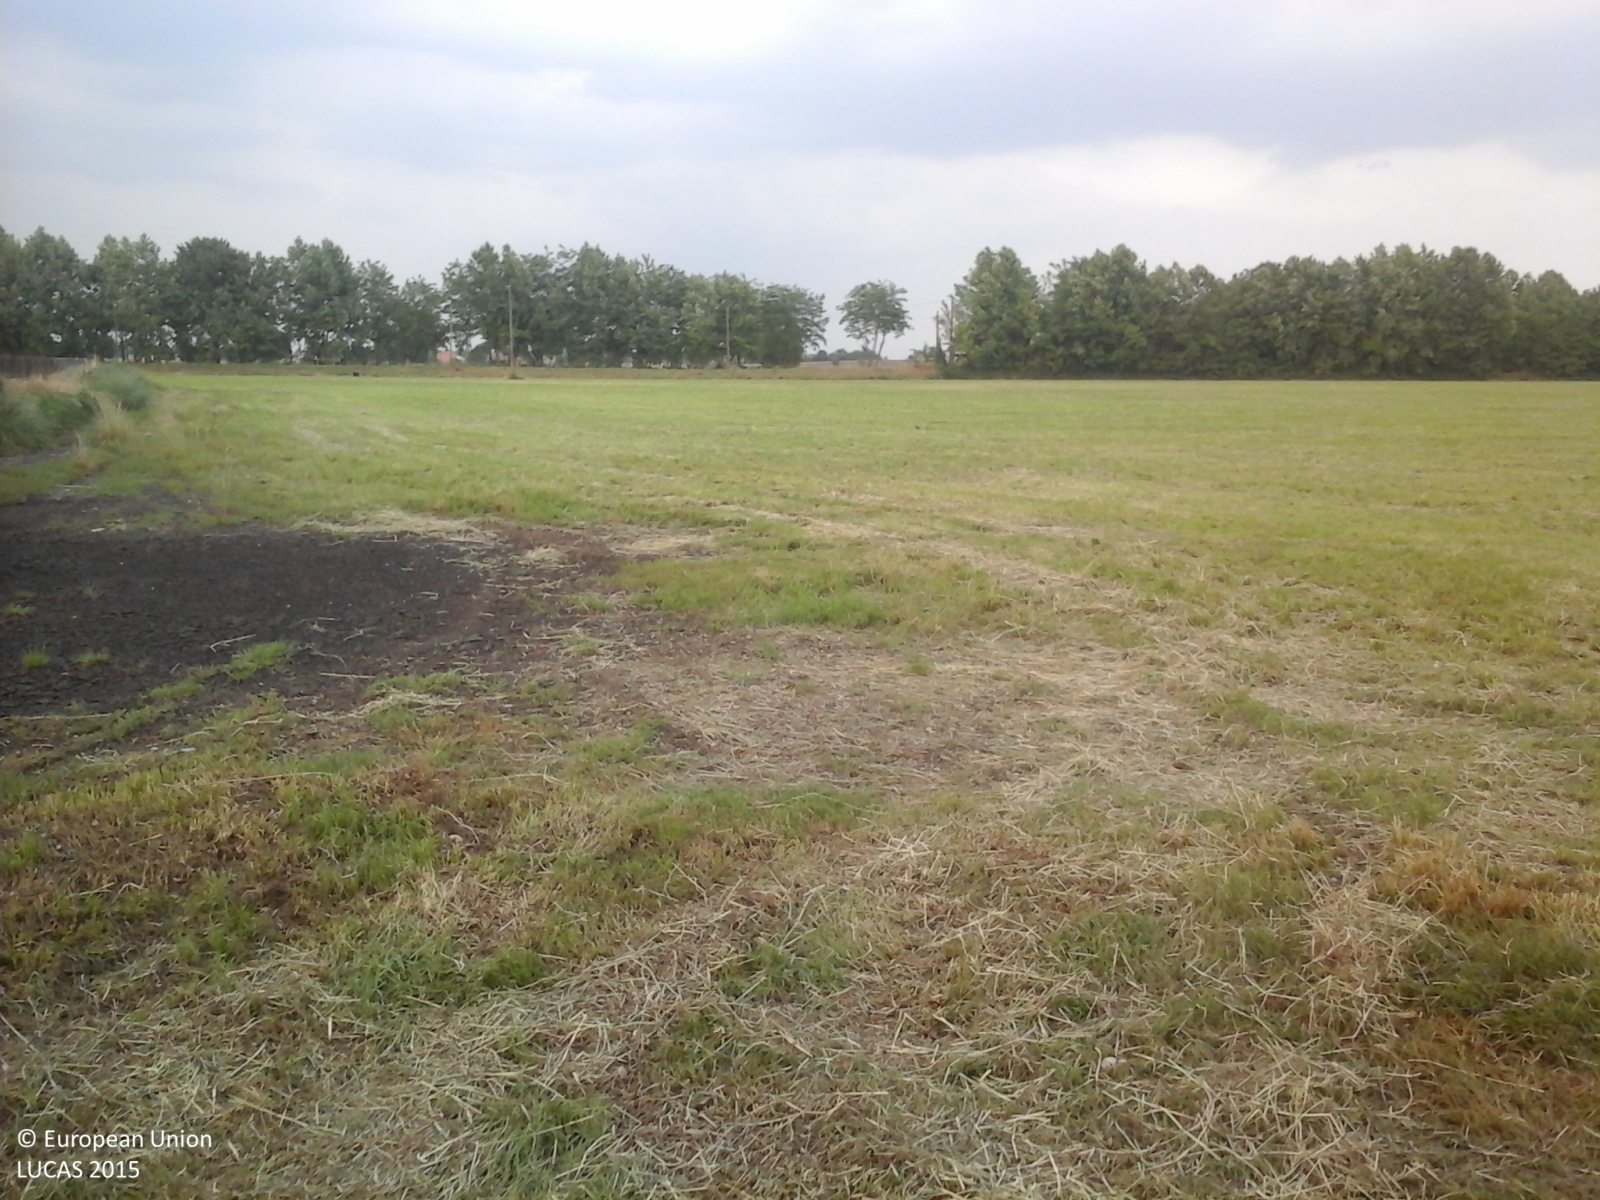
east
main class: Grassland
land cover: Grassland without tree/shrub cover
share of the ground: > 75 %
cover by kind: herbaceous plants 100 %
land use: Agriculture (excluding fallow land and kitchen gardens)
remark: Harvested field
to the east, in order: Grassland without tree/shrub cover; Managed hedges; Inland fresh running water; Managed hedges; Grassland without tree/shrub cover; Electric lines; Grass margins; Paved roads, cycling and walking lanes; Grass margins
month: May
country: IT
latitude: 45.2137
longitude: 10.6990
